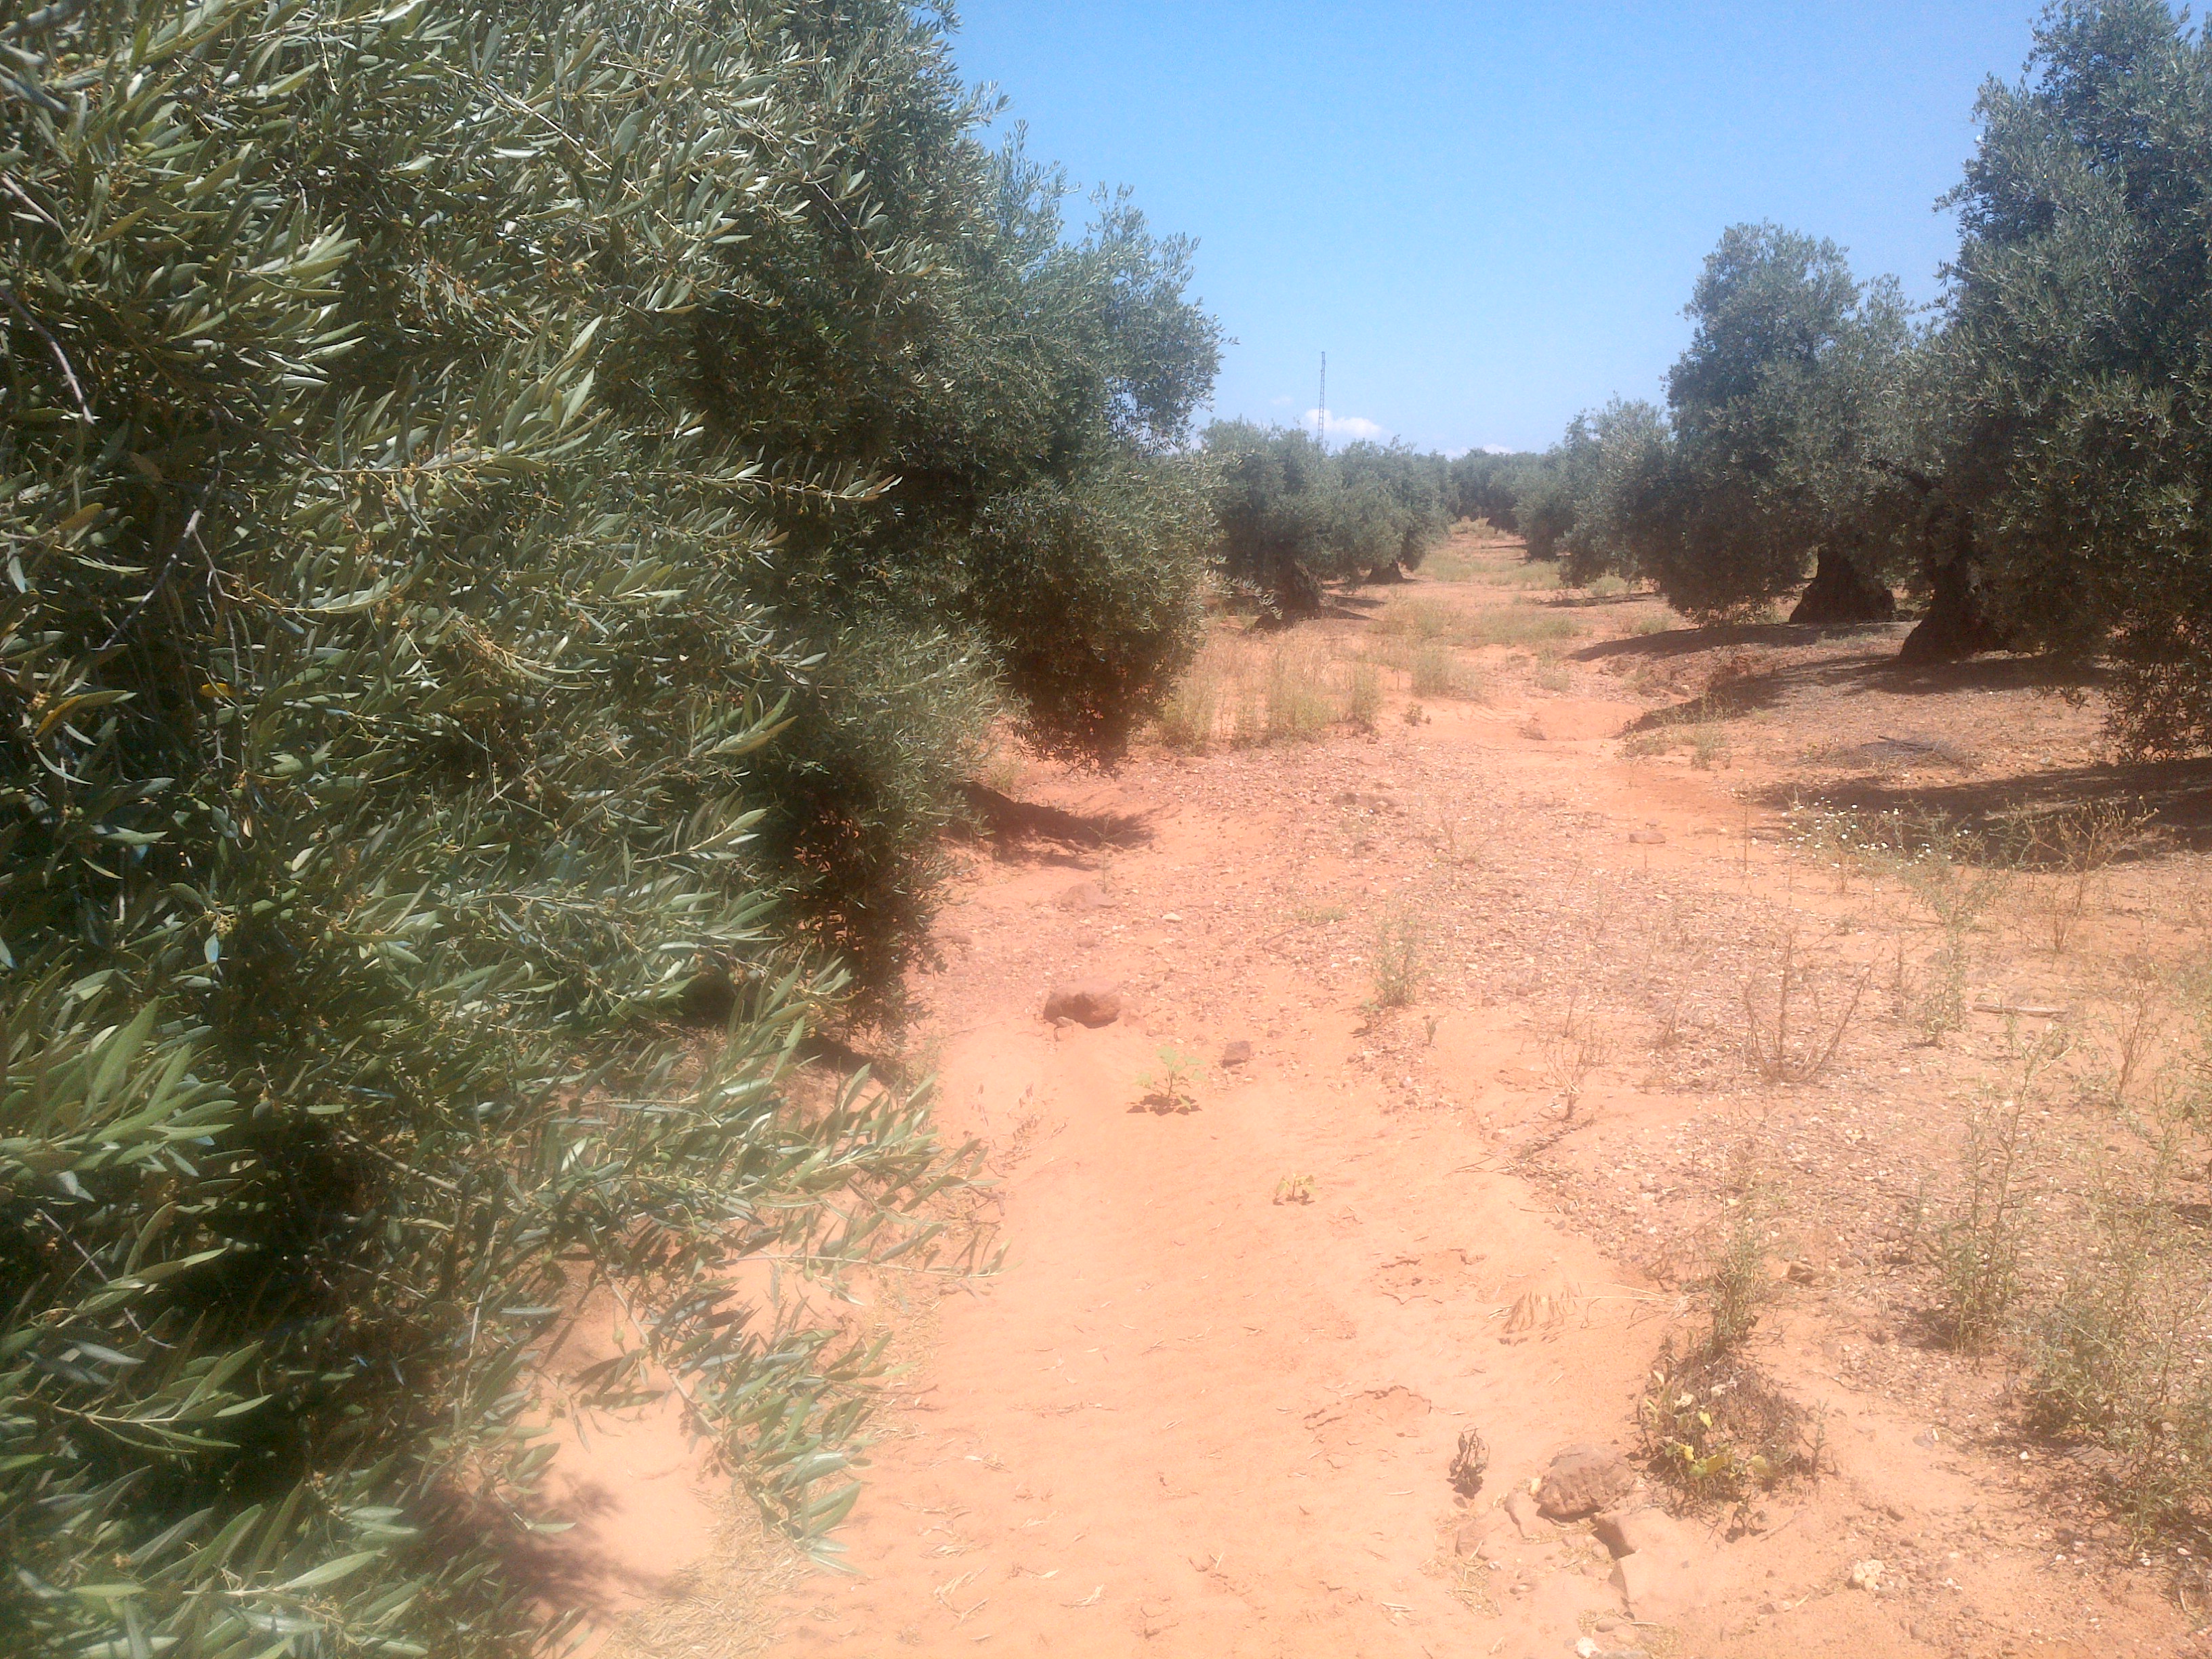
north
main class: Cropland
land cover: Olive groves
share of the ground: 50 - 75 %
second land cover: Spontaneously vegetated surfaces
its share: 10 - 25 %
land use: Agriculture (excluding fallow land and kitchen gardens)
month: June
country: ES
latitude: 38.0519
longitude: -4.3362
